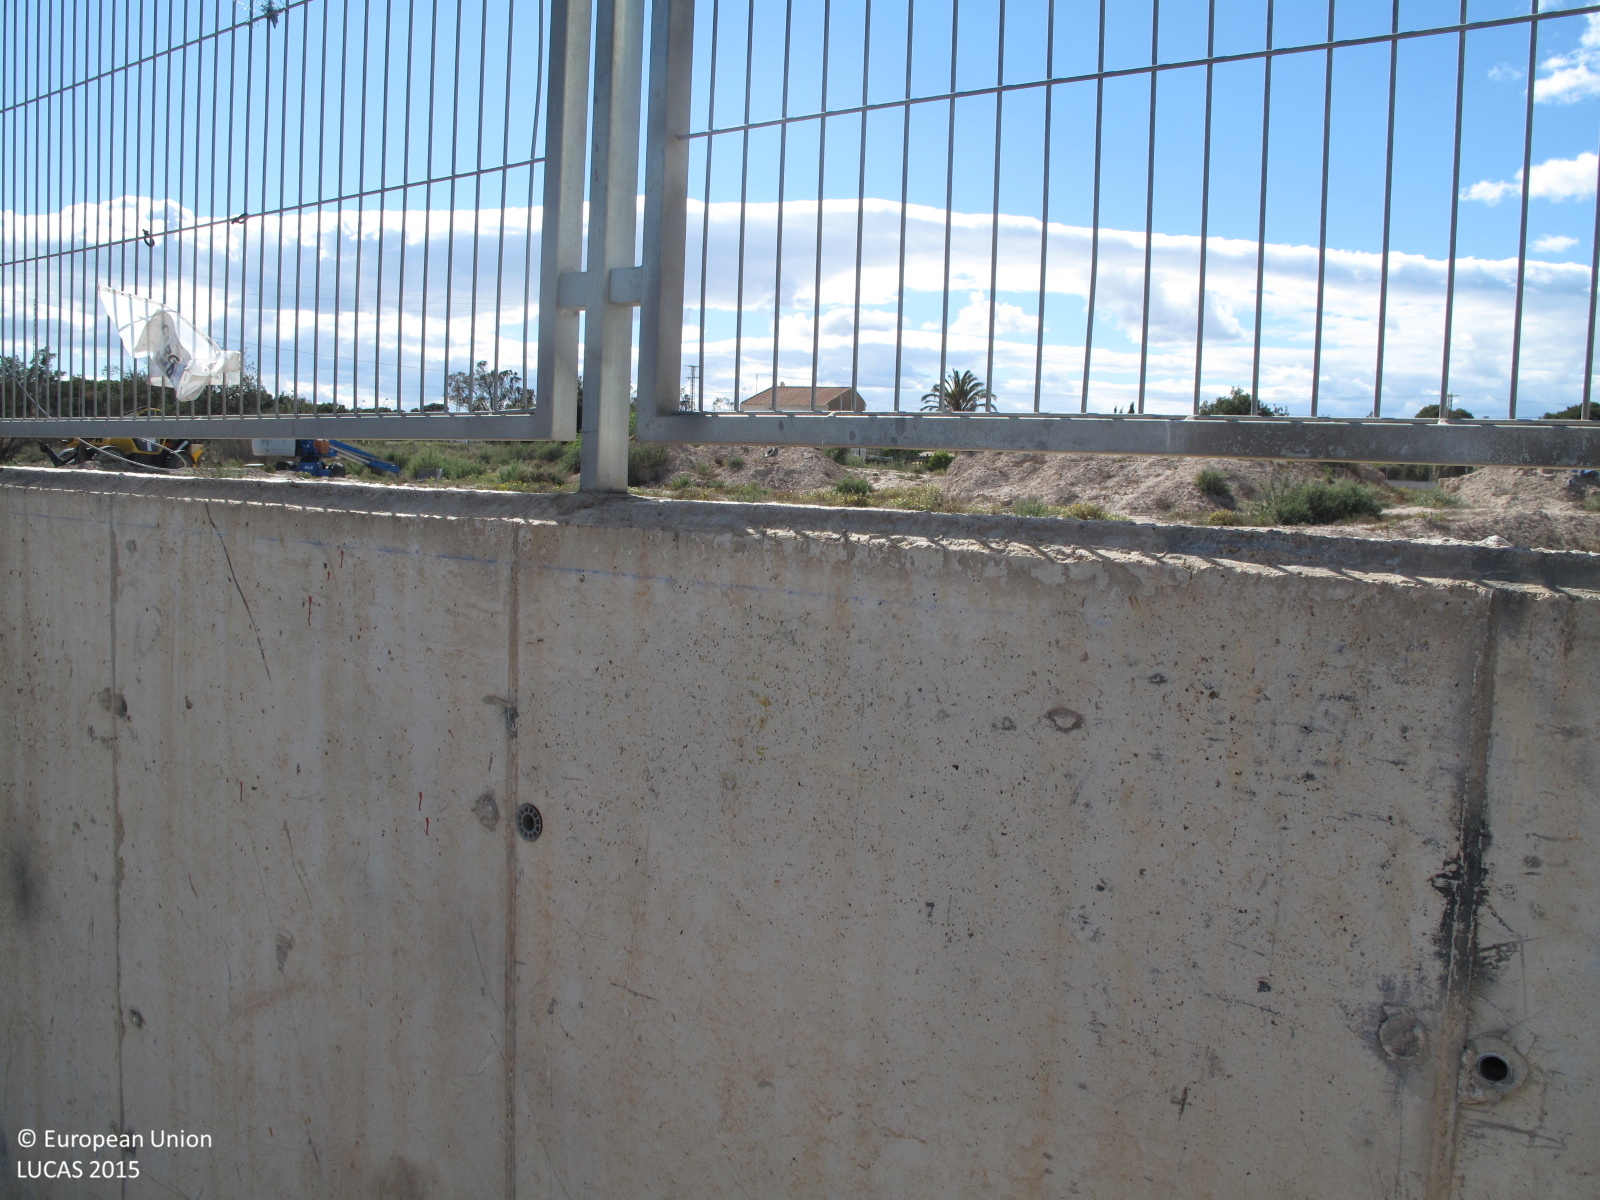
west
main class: Shrubland
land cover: Shrubland with sparse tree cover
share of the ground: 25 - 50 %
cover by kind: shrubs 40 %, herbaceous plants 40 %, consolidated bare surface 15 %, broadleaved forest trees 5 %
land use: Abandoned areas
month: April
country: ES
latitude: 38.4157
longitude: -0.4197
